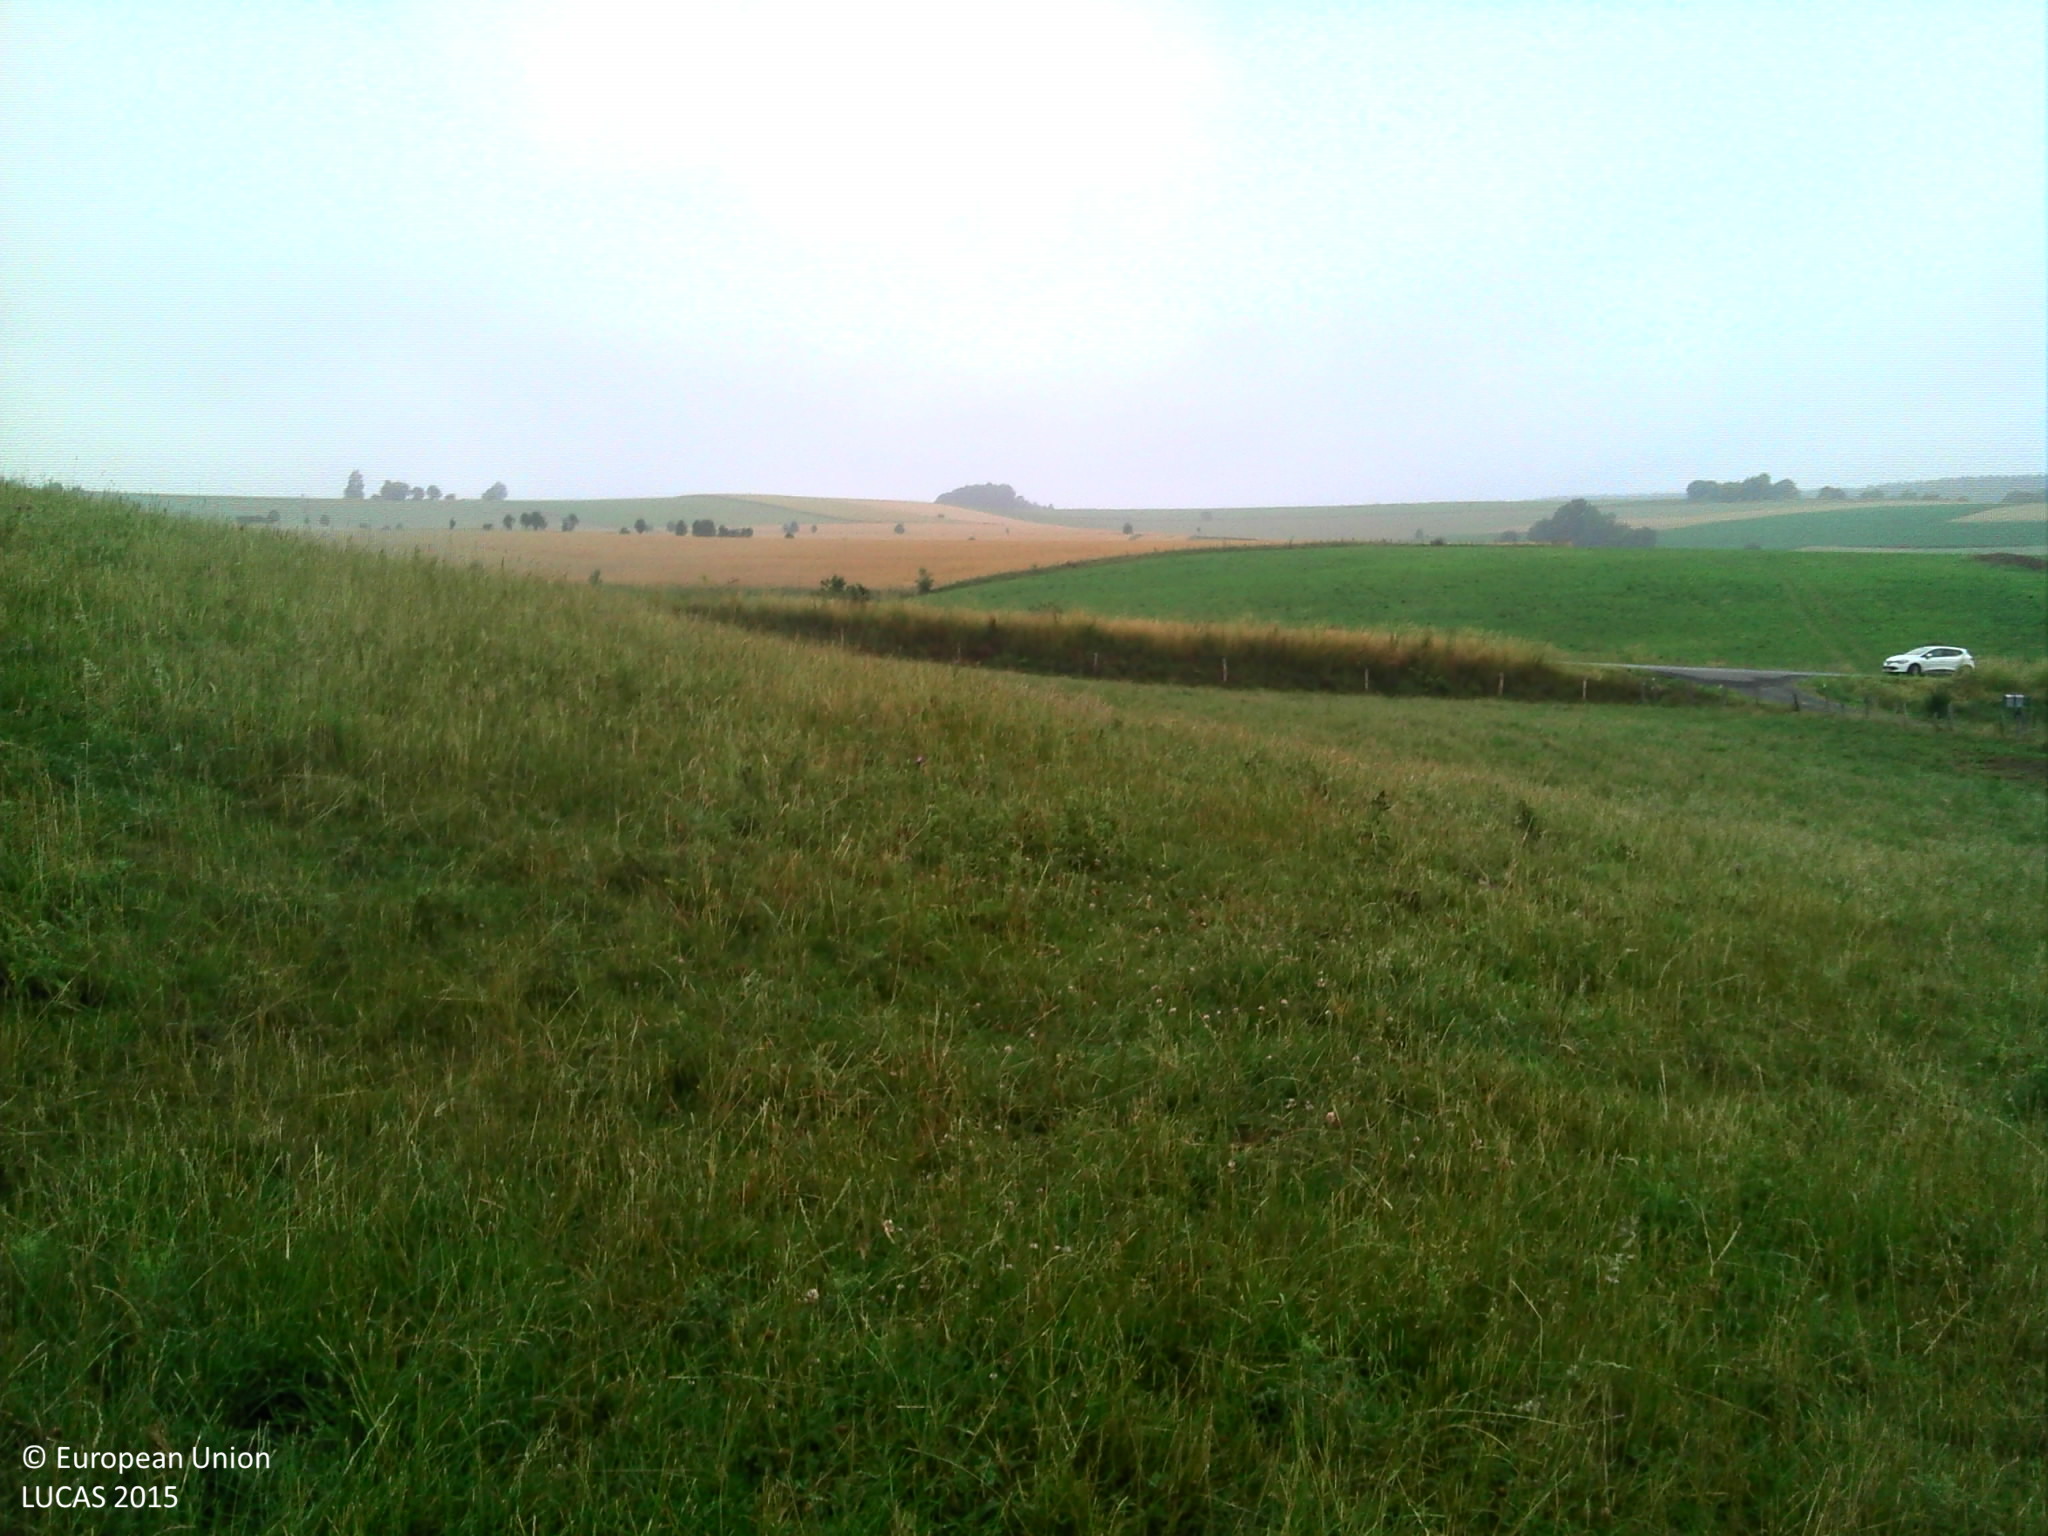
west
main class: Grassland
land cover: Grassland without tree/shrub cover
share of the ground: > 75 %
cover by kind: herbaceous plants 100 %
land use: Agriculture (excluding fallow land and kitchen gardens)
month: July
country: BE
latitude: 50.0453
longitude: 5.5997
